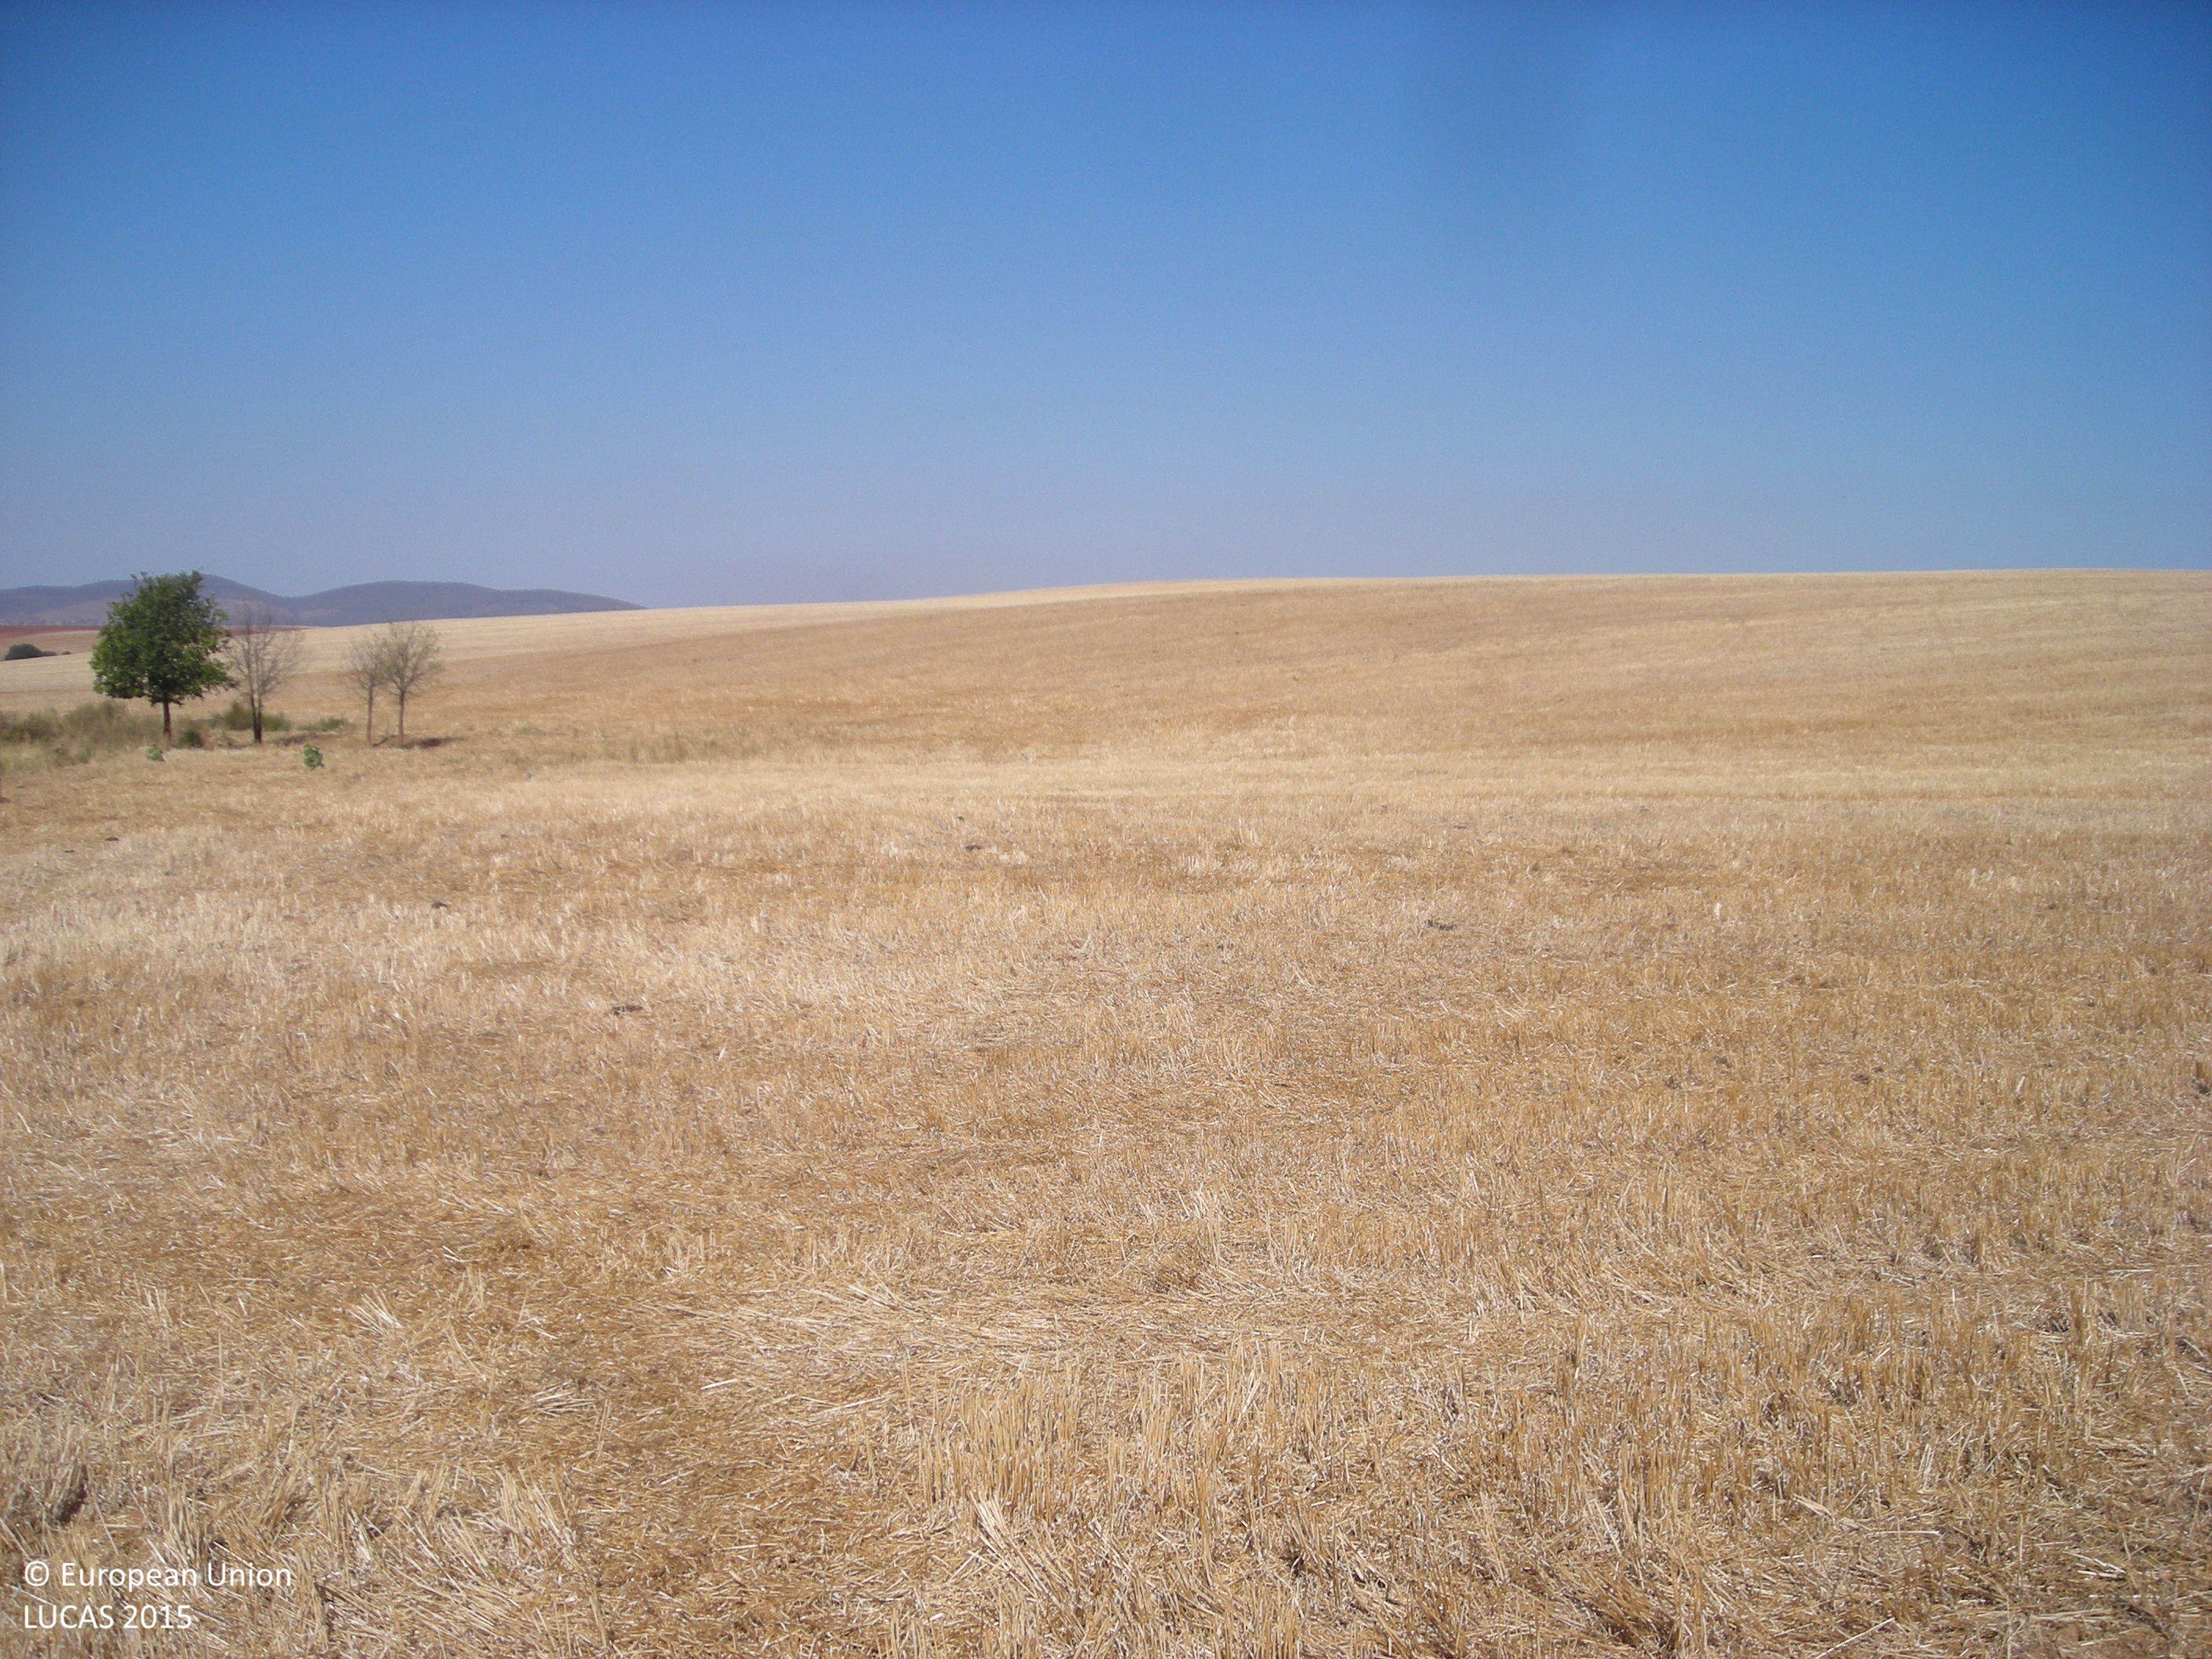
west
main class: Cropland
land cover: Oats
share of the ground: > 75 %
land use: Agriculture (excluding fallow land and kitchen gardens)
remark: Harvested field
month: July
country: ES
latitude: 38.8383
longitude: -5.8651
